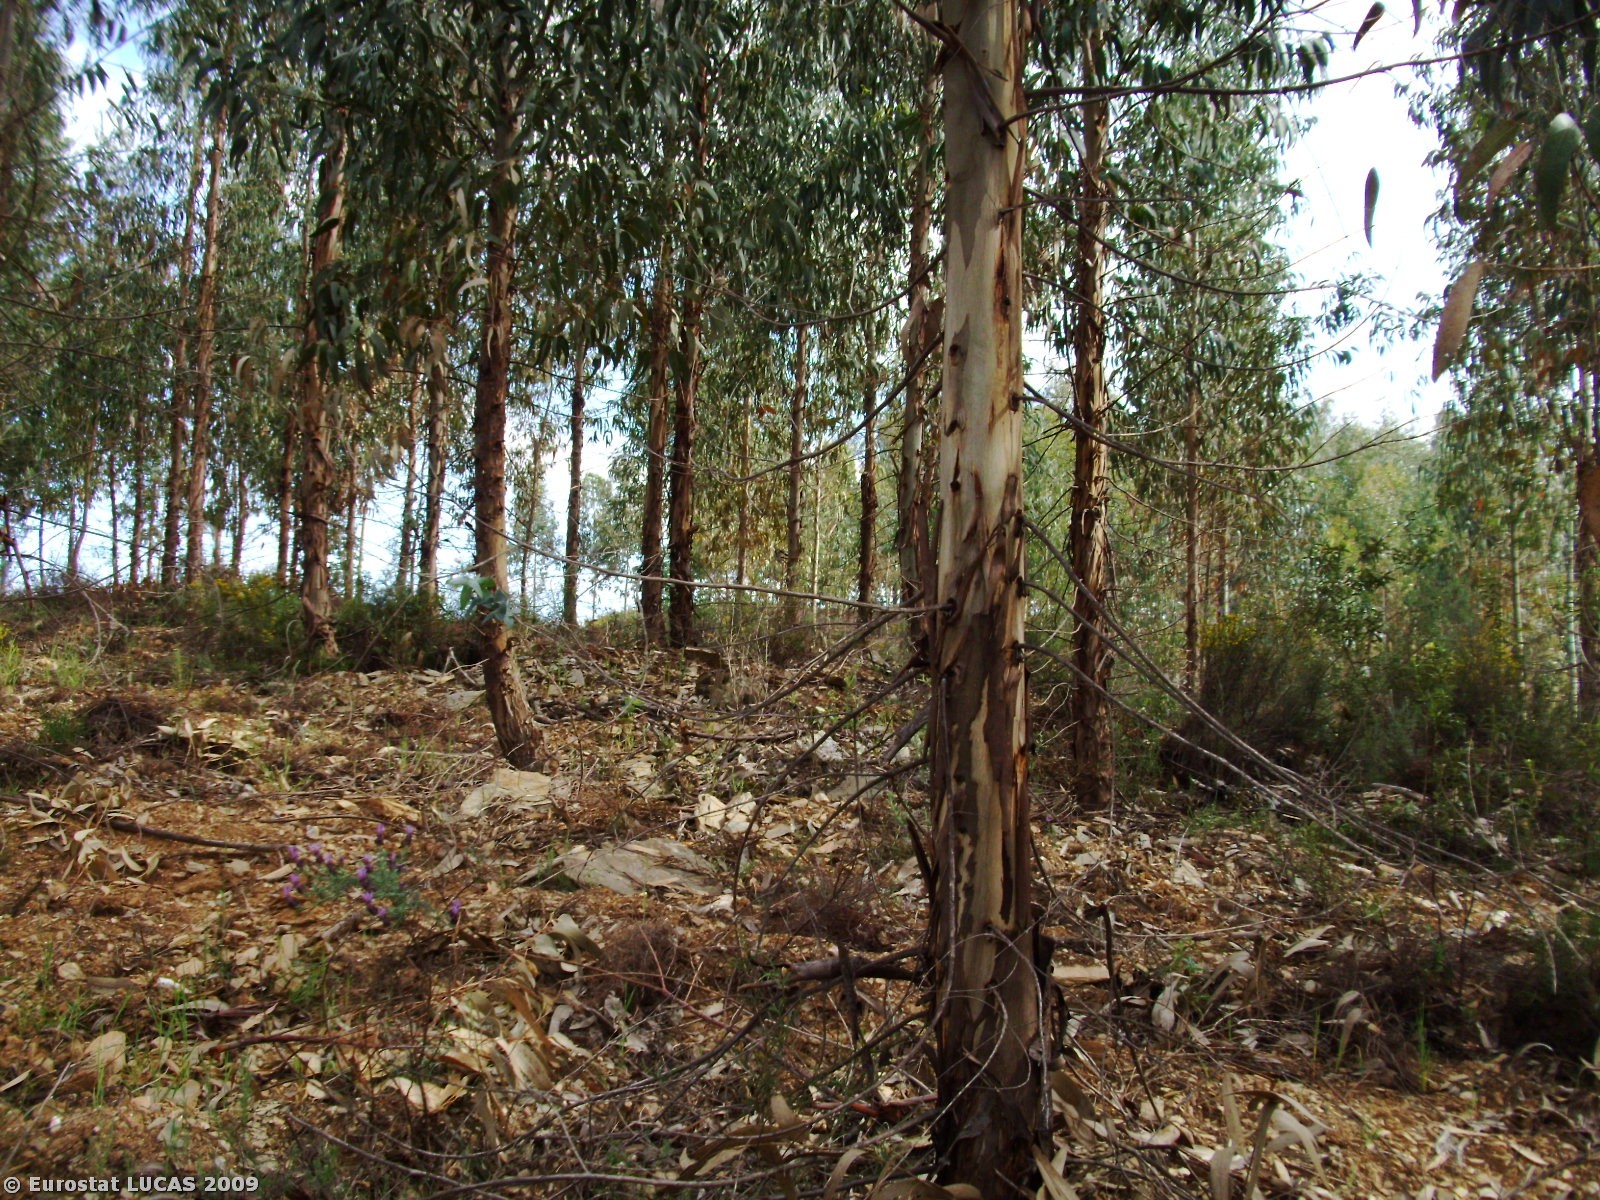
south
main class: Woodland
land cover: Broadleaved woodland
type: plantations and self-sown exotic forest
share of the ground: 25 - 50 %
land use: Forestry
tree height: > 5 m
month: April
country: PT
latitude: 39.8092
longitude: -7.5873
